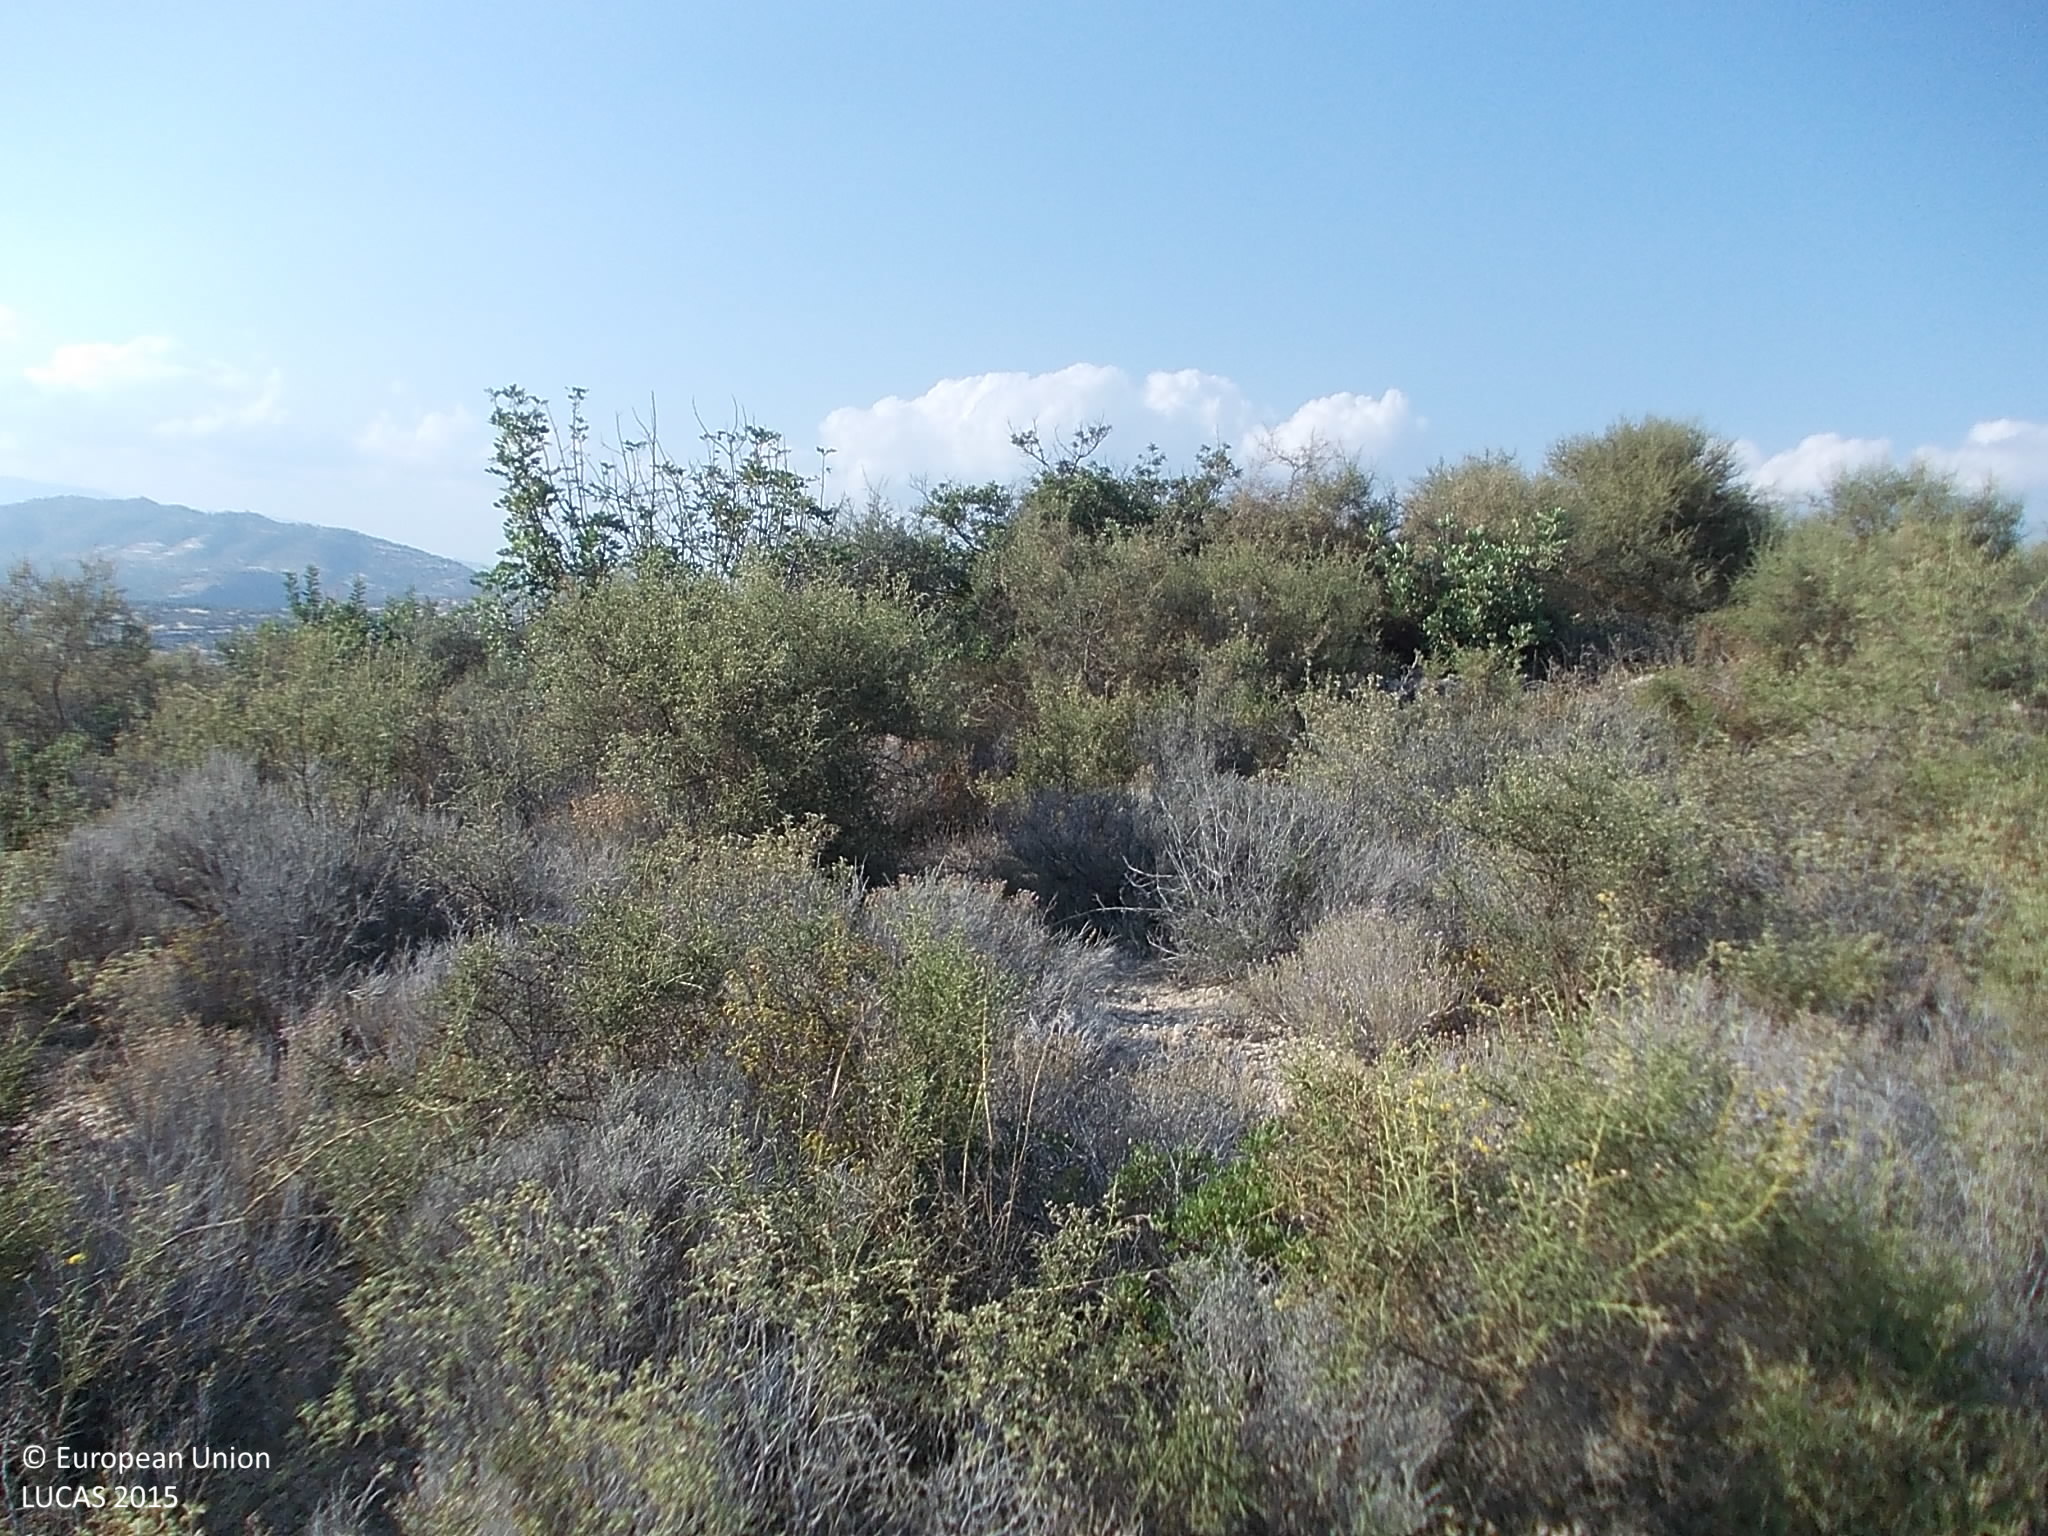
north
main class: Shrubland
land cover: Shrubland without tree cover
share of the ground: > 75 %
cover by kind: shrubs 90 %, unconsolidated bare surface 10 %
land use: Semi-natural and natural areas not in use
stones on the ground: 10 - 25 %
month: August
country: CY
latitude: 34.7543
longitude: 33.0084
